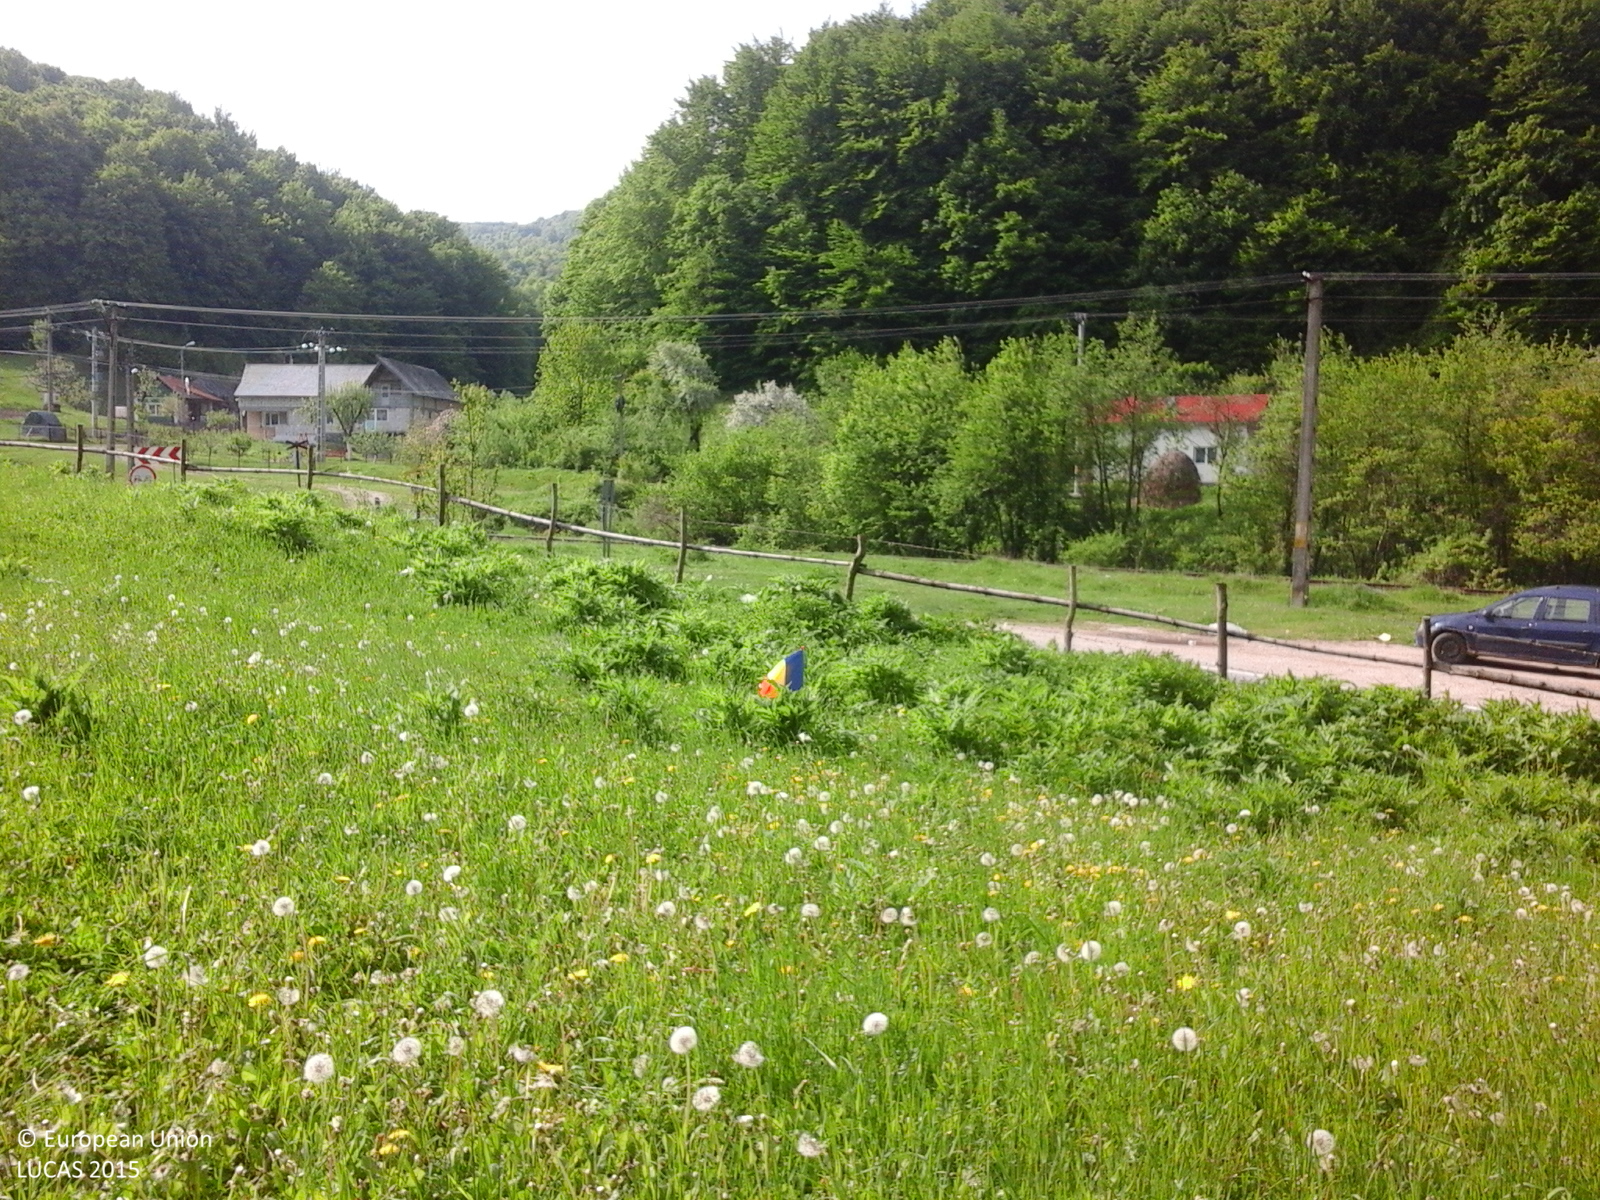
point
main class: Grassland
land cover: Grassland without tree/shrub cover
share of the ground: > 75 %
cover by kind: herbaceous plants 100 %
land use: Agriculture (excluding fallow land and kitchen gardens)
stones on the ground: < 10 %
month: May
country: RO
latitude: 45.6778
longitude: 25.9423
